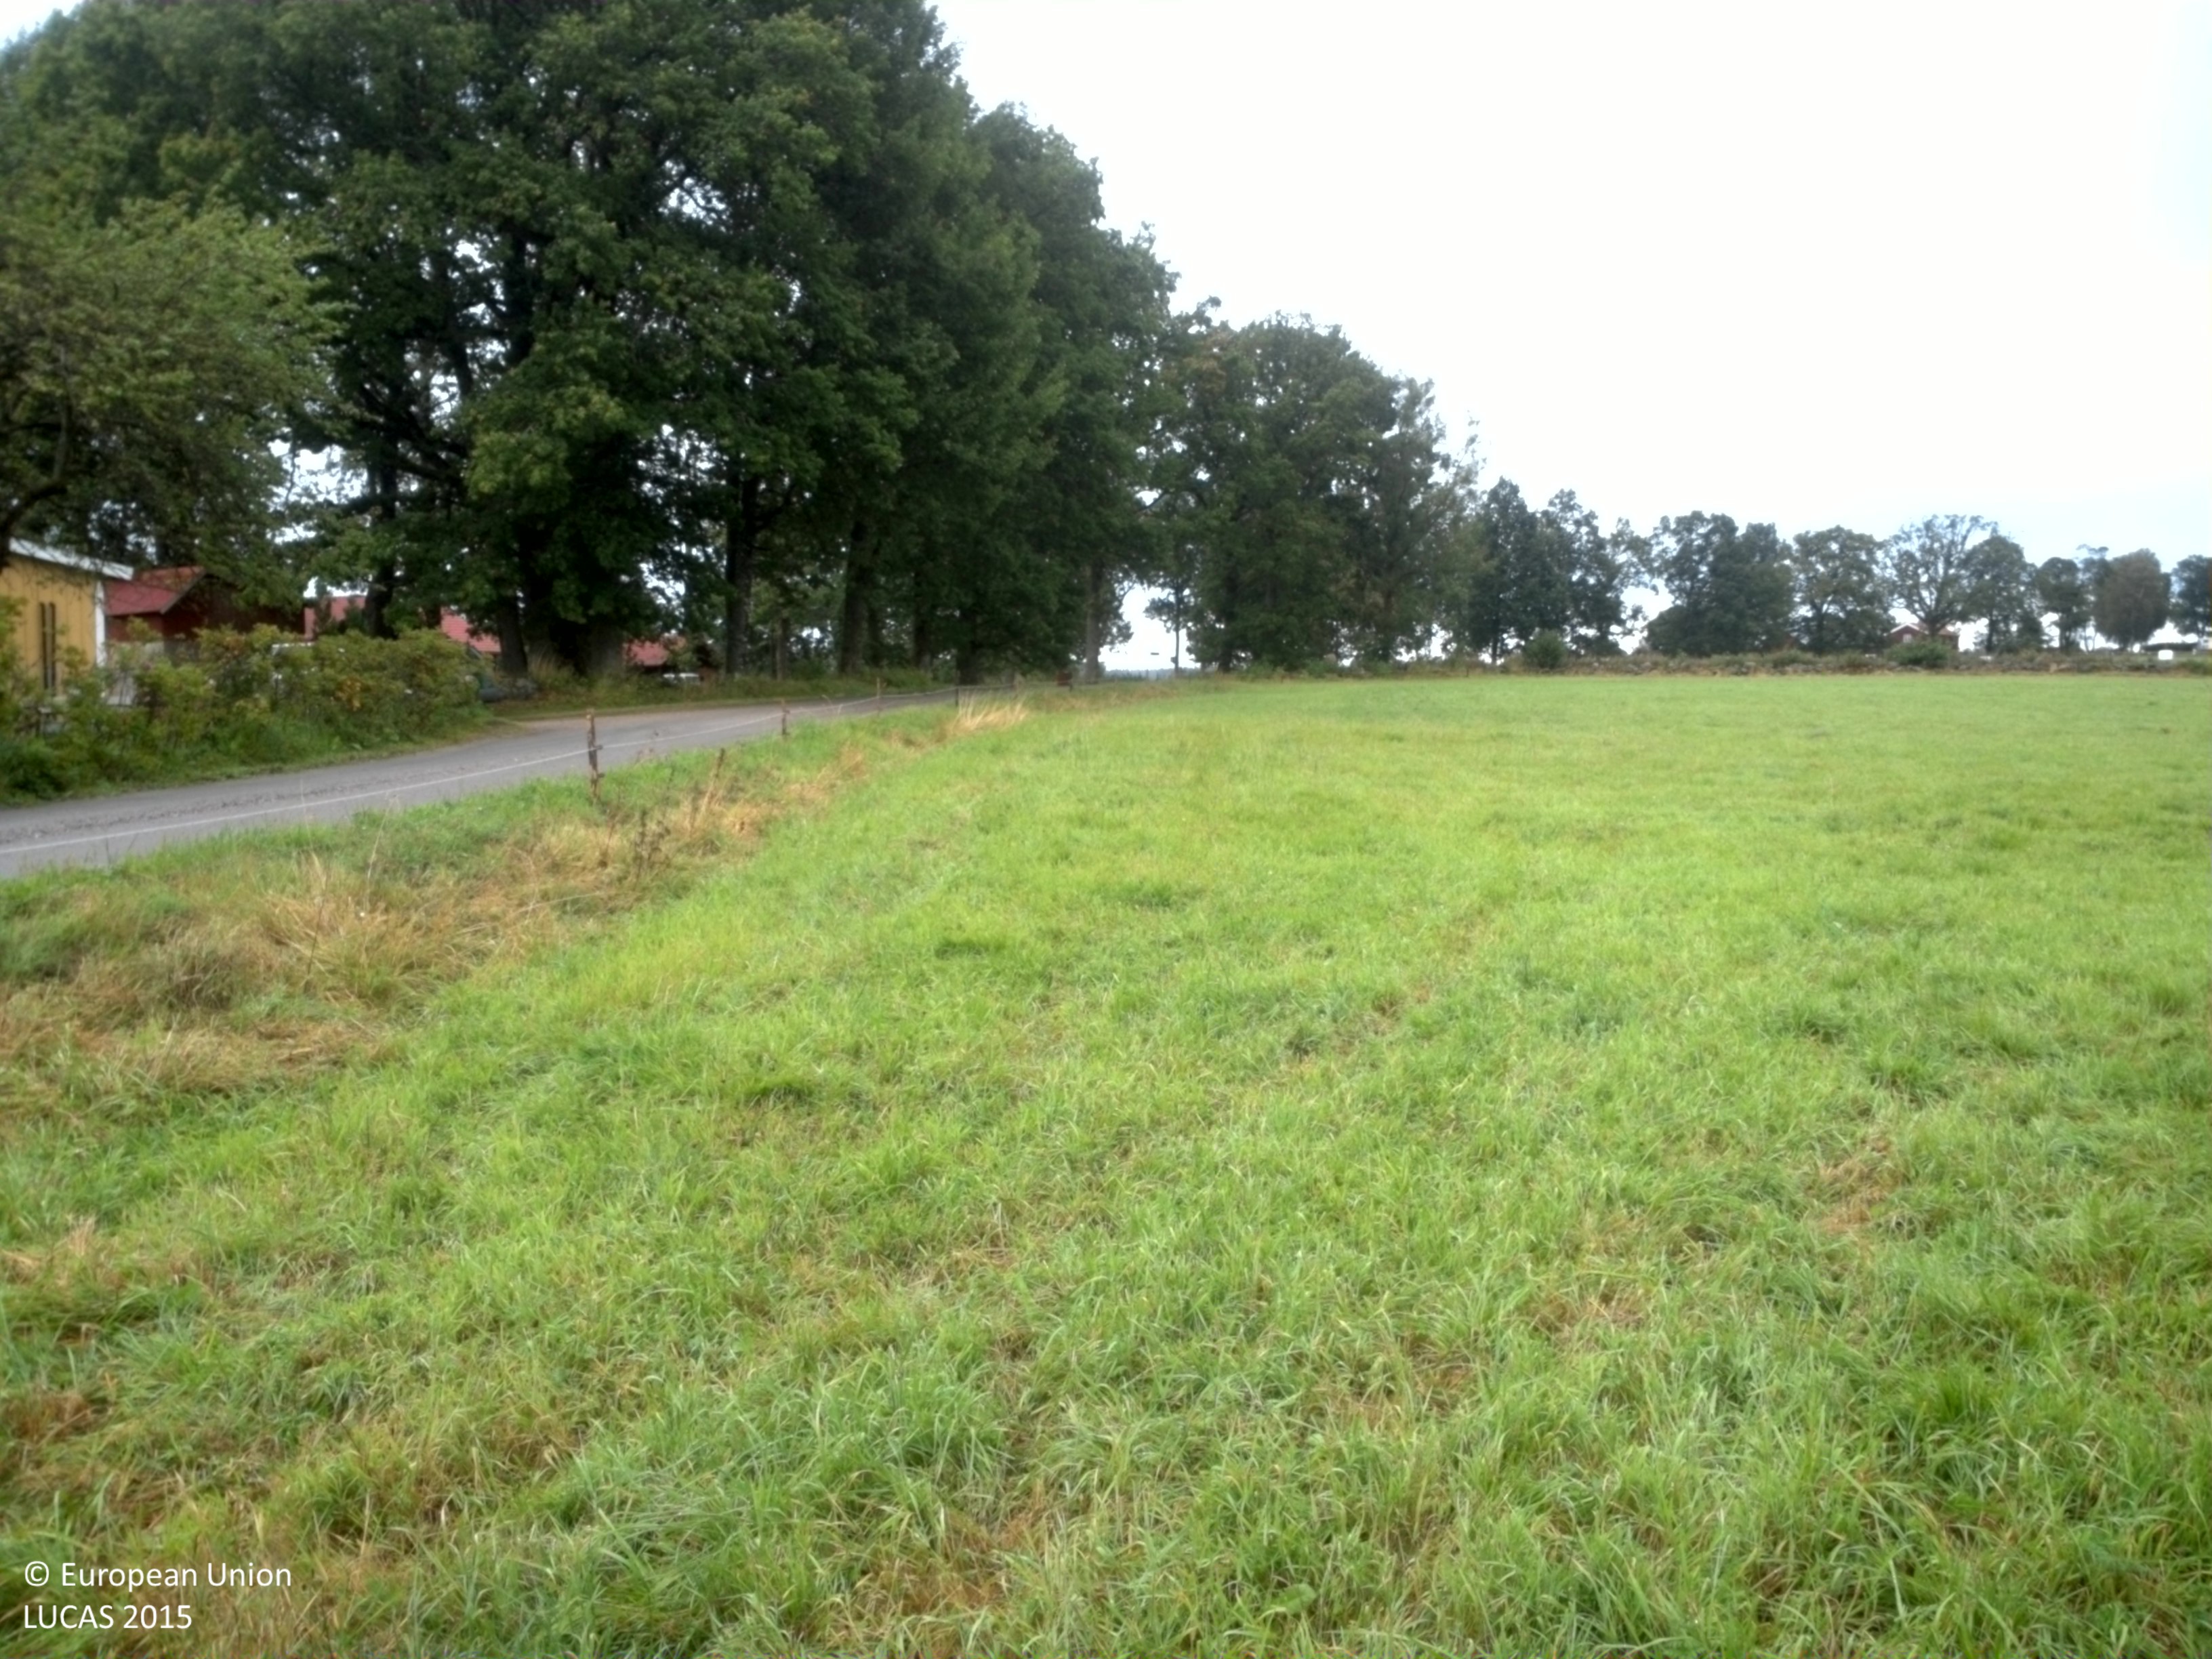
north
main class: Cropland
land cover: Temporary grasslands
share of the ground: > 75 %
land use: Agriculture (excluding fallow land and kitchen gardens)
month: August
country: SE
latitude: 57.8415
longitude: 13.1116
